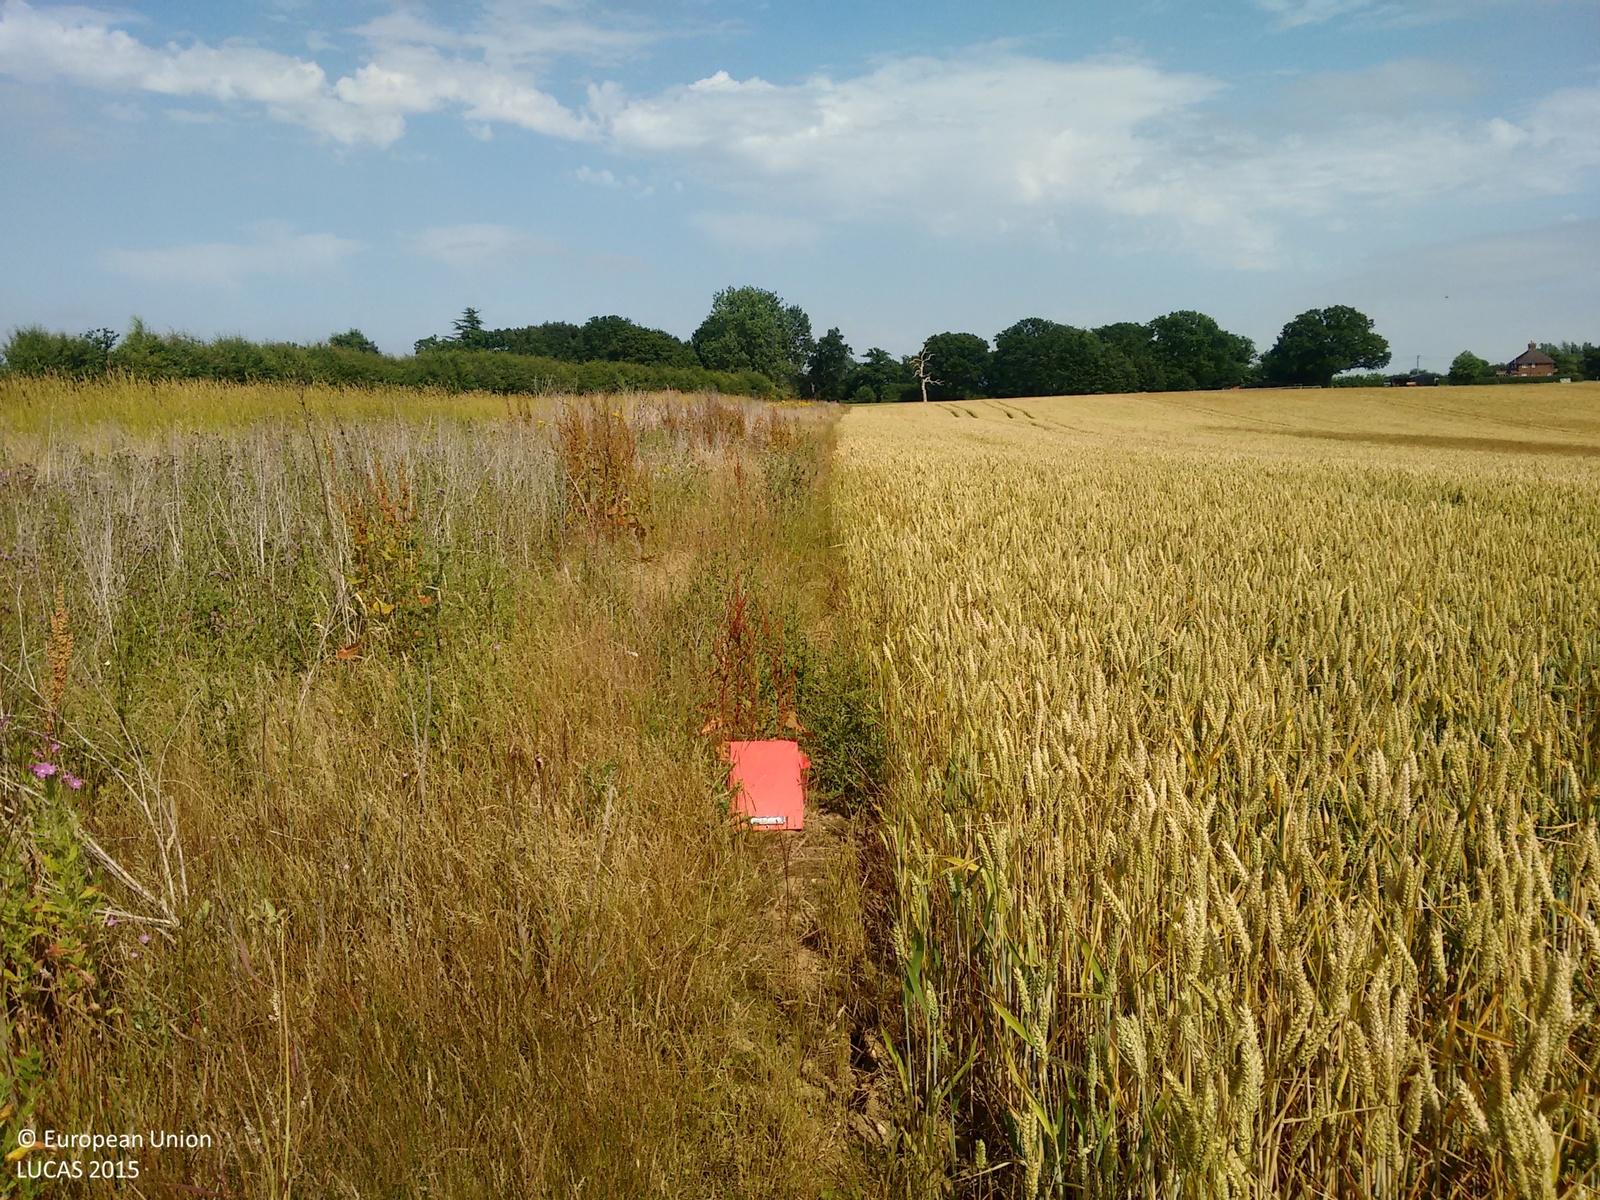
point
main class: Grassland
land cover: Spontaneously vegetated surfaces
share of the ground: > 75 %
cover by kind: herbaceous plants 100 %
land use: Fallow land
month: July
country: GB
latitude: 51.6985
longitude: 0.4075
